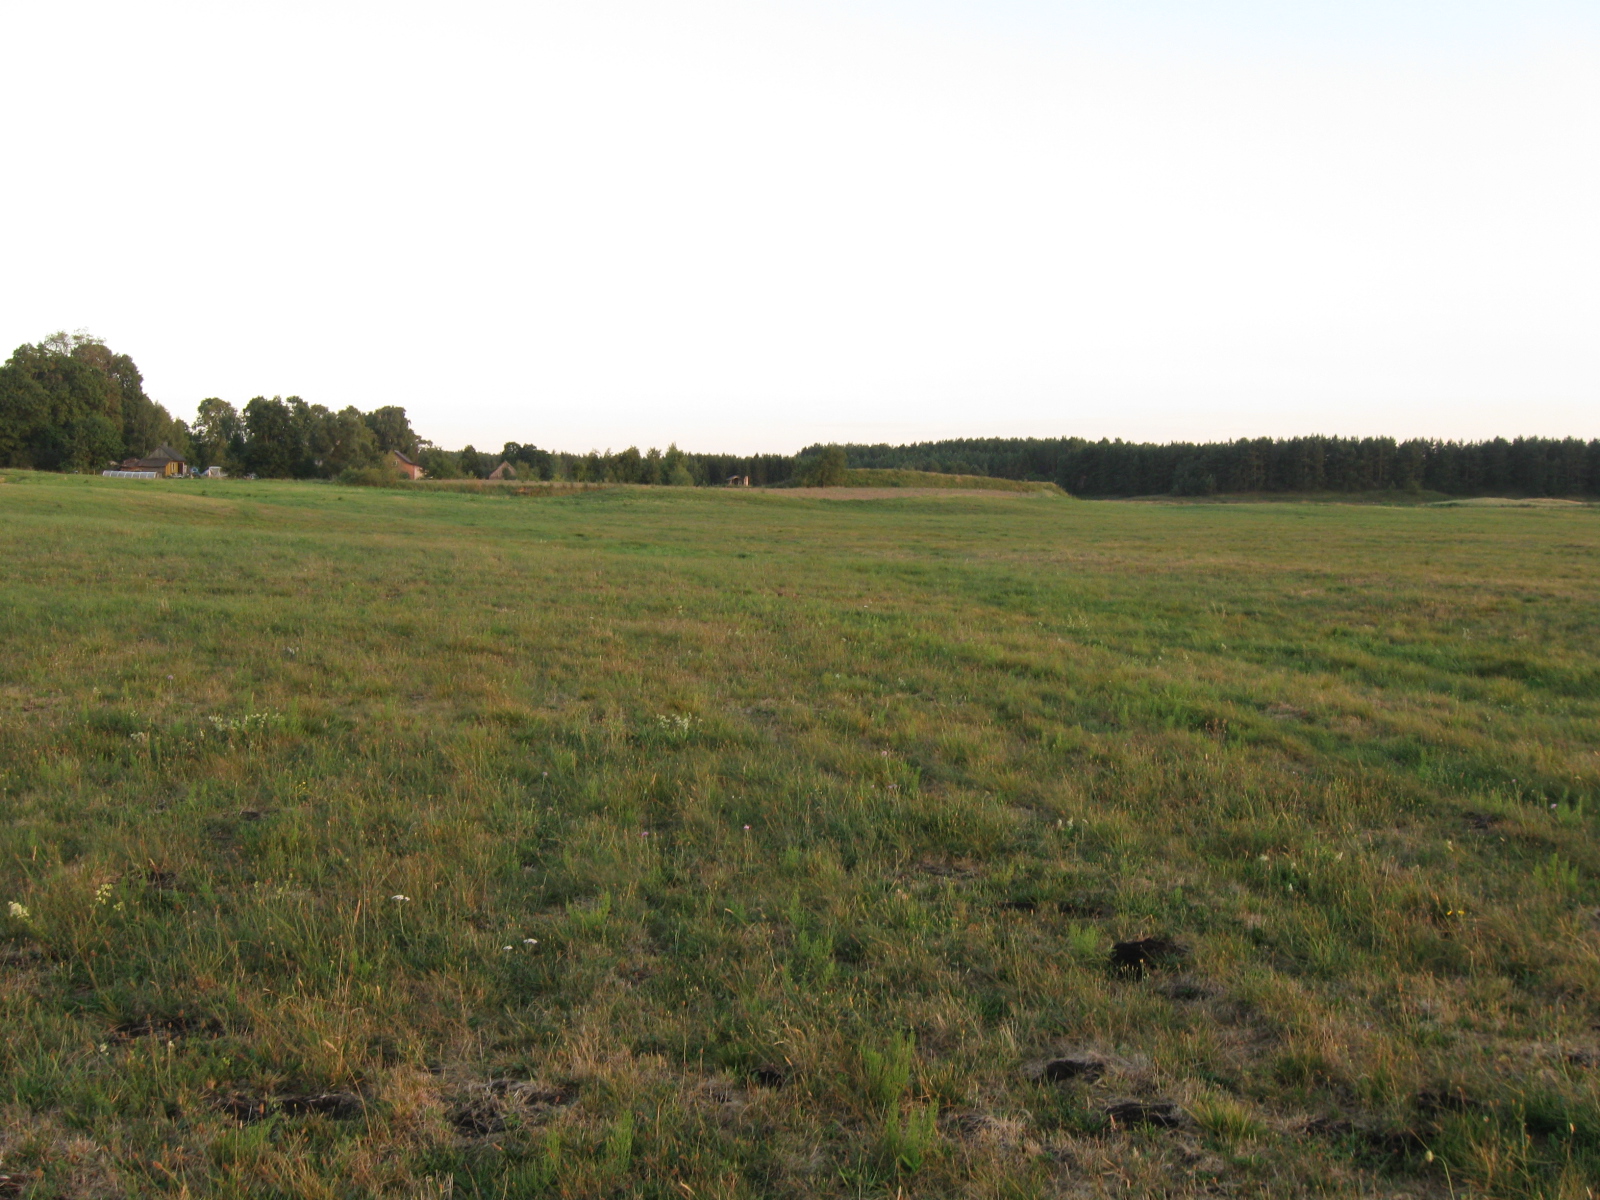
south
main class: Grassland
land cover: Grassland without tree/shrub cover
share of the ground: > 75 %
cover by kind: herbaceous plants 90 %, unconsolidated bare surface 10 %
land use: Agriculture (excluding fallow land and kitchen gardens)
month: July
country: LT
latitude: 54.2634
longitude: 23.5164
